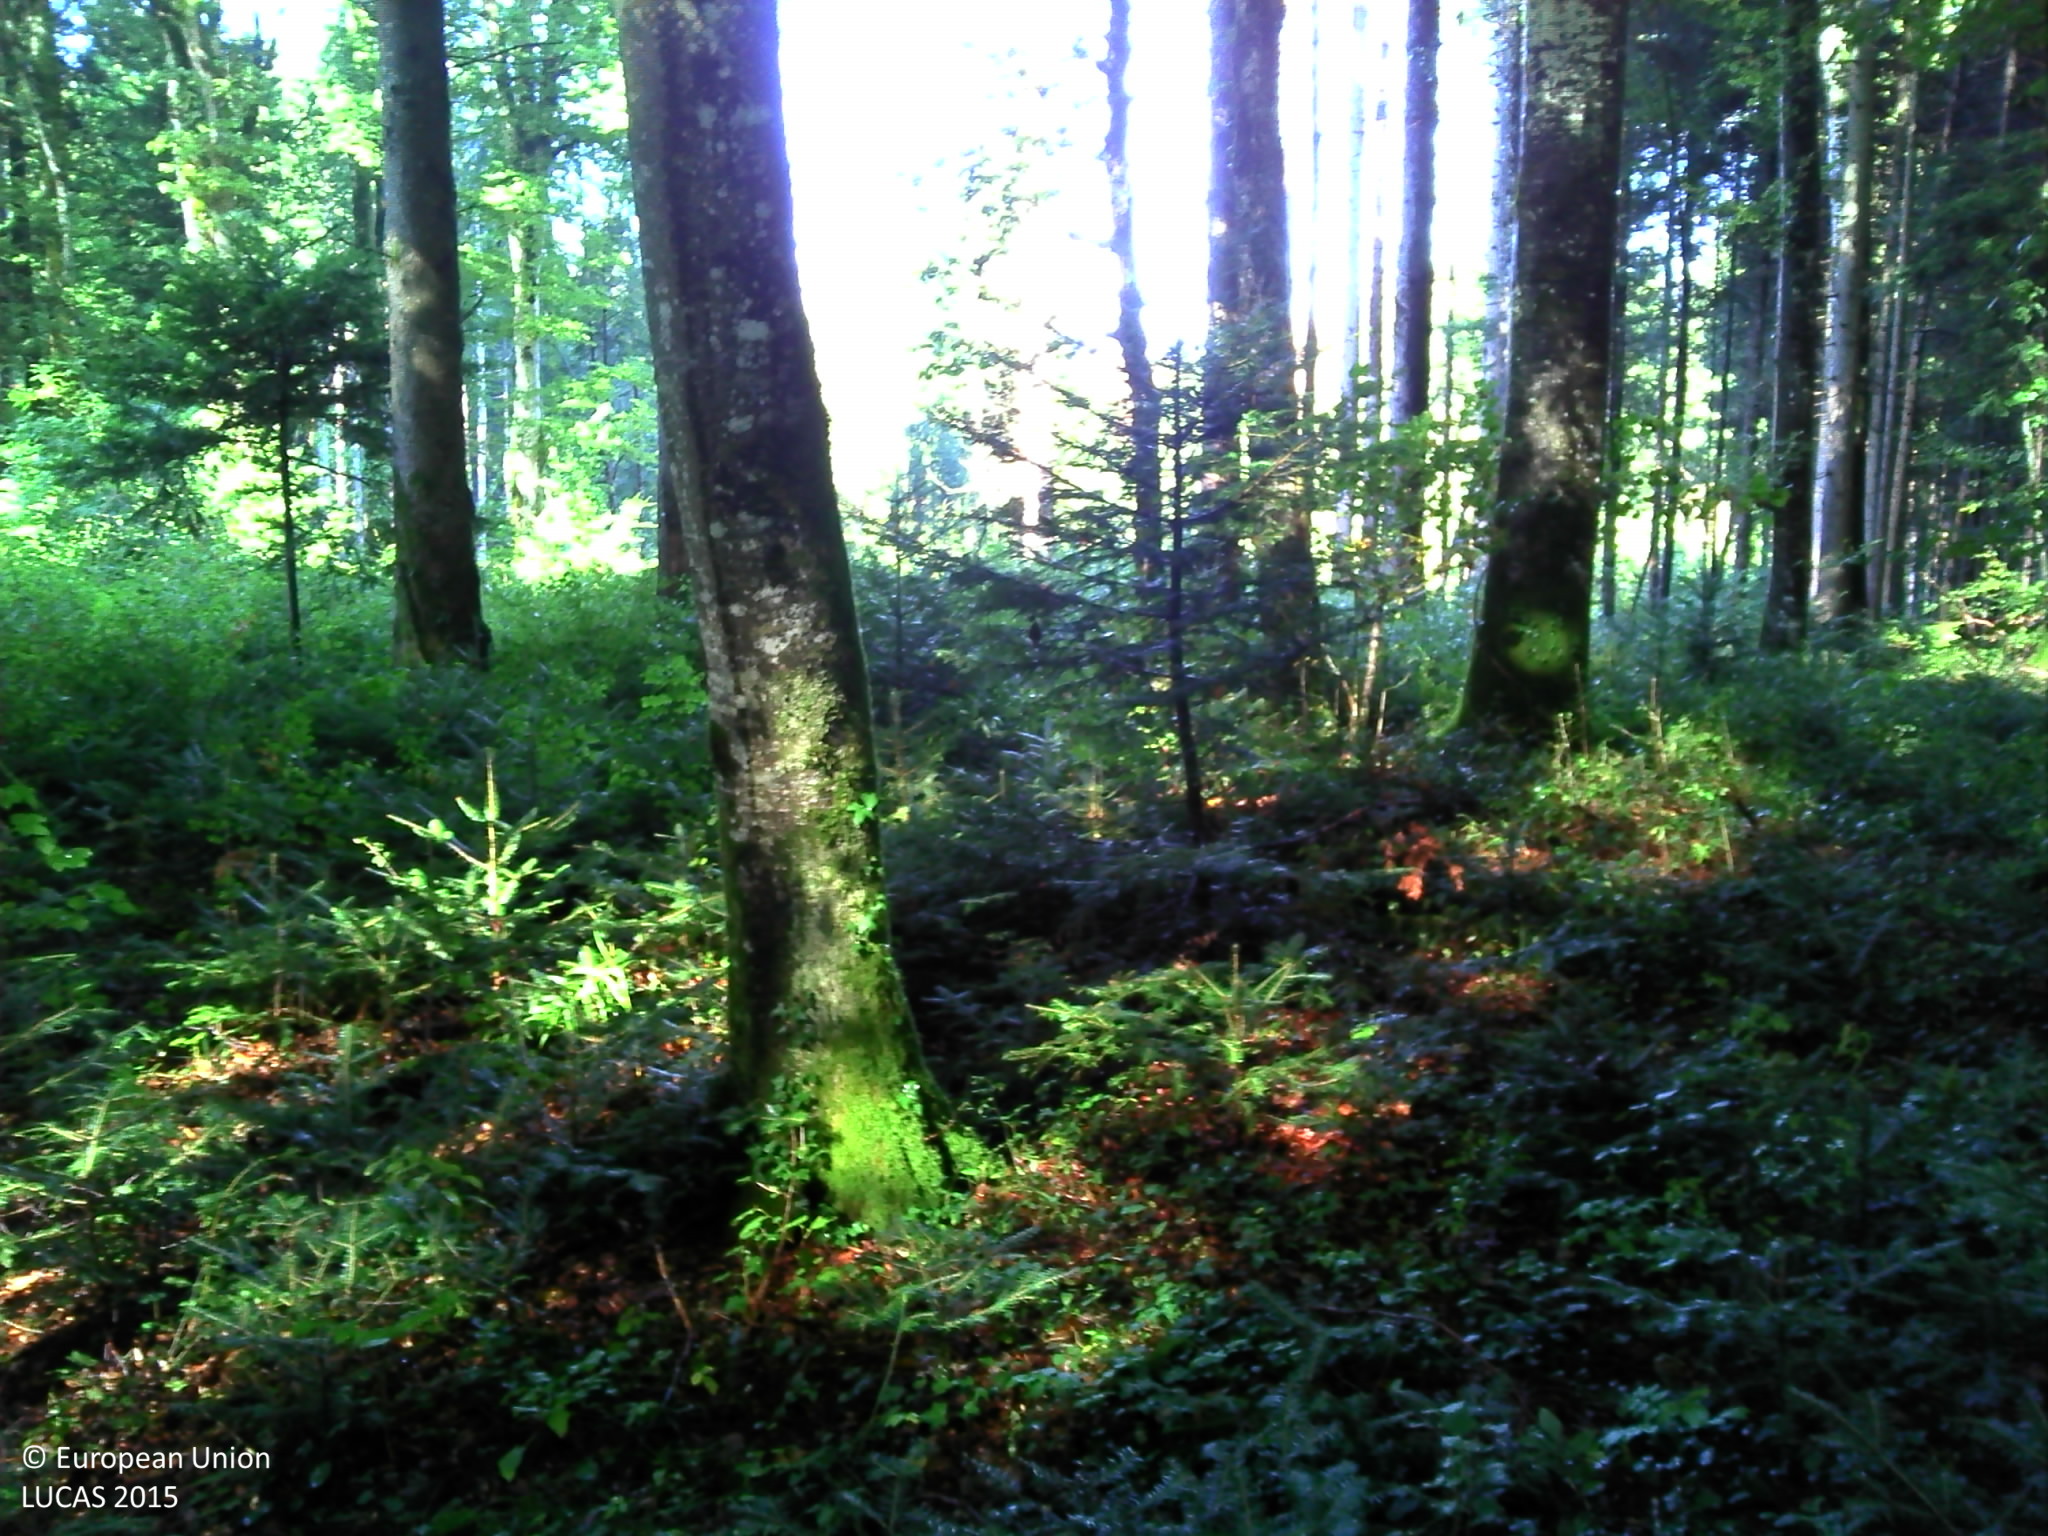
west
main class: Woodland
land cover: Broadleaved woodland
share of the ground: > 75 %
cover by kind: broadleaved forest trees 85 %, coniferous forest trees 5 %, herbaceous plants 5 %, unconsolidated bare surface 5 %
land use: Forestry
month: September
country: FR
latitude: 47.0975
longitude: 6.2735
